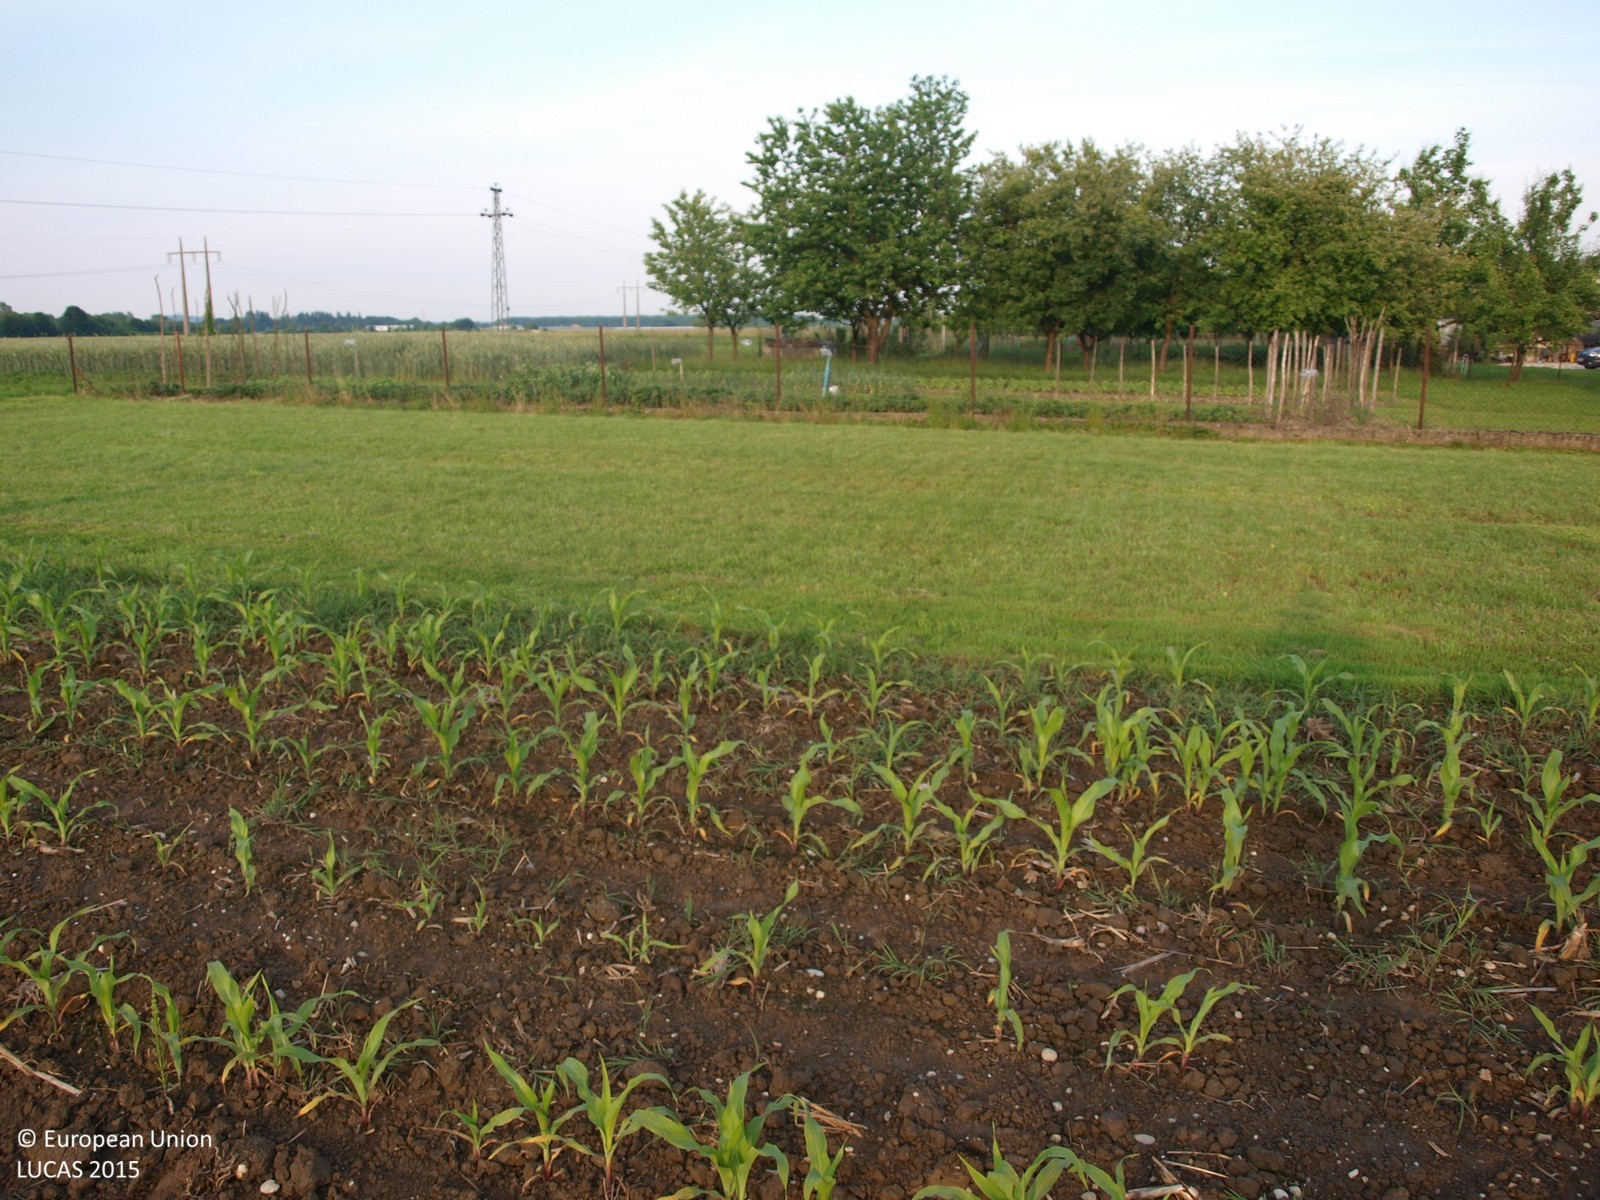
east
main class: Cropland
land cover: Maize
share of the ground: 10 - 25 %
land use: Agriculture (excluding fallow land and kitchen gardens)
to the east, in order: Maize; Grassland without tree/shrub cover; Fences; Cherry fruit; Fences; Maize; Potatoes; Maize; Grassland without tree/shrub cover; Electric lines; Grassland without tree/shrub cover; Paved roads, cycling and walking lanes; Spontaneously vegetated surfaces; Maize
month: June
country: HR
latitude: 46.3759
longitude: 16.0970
